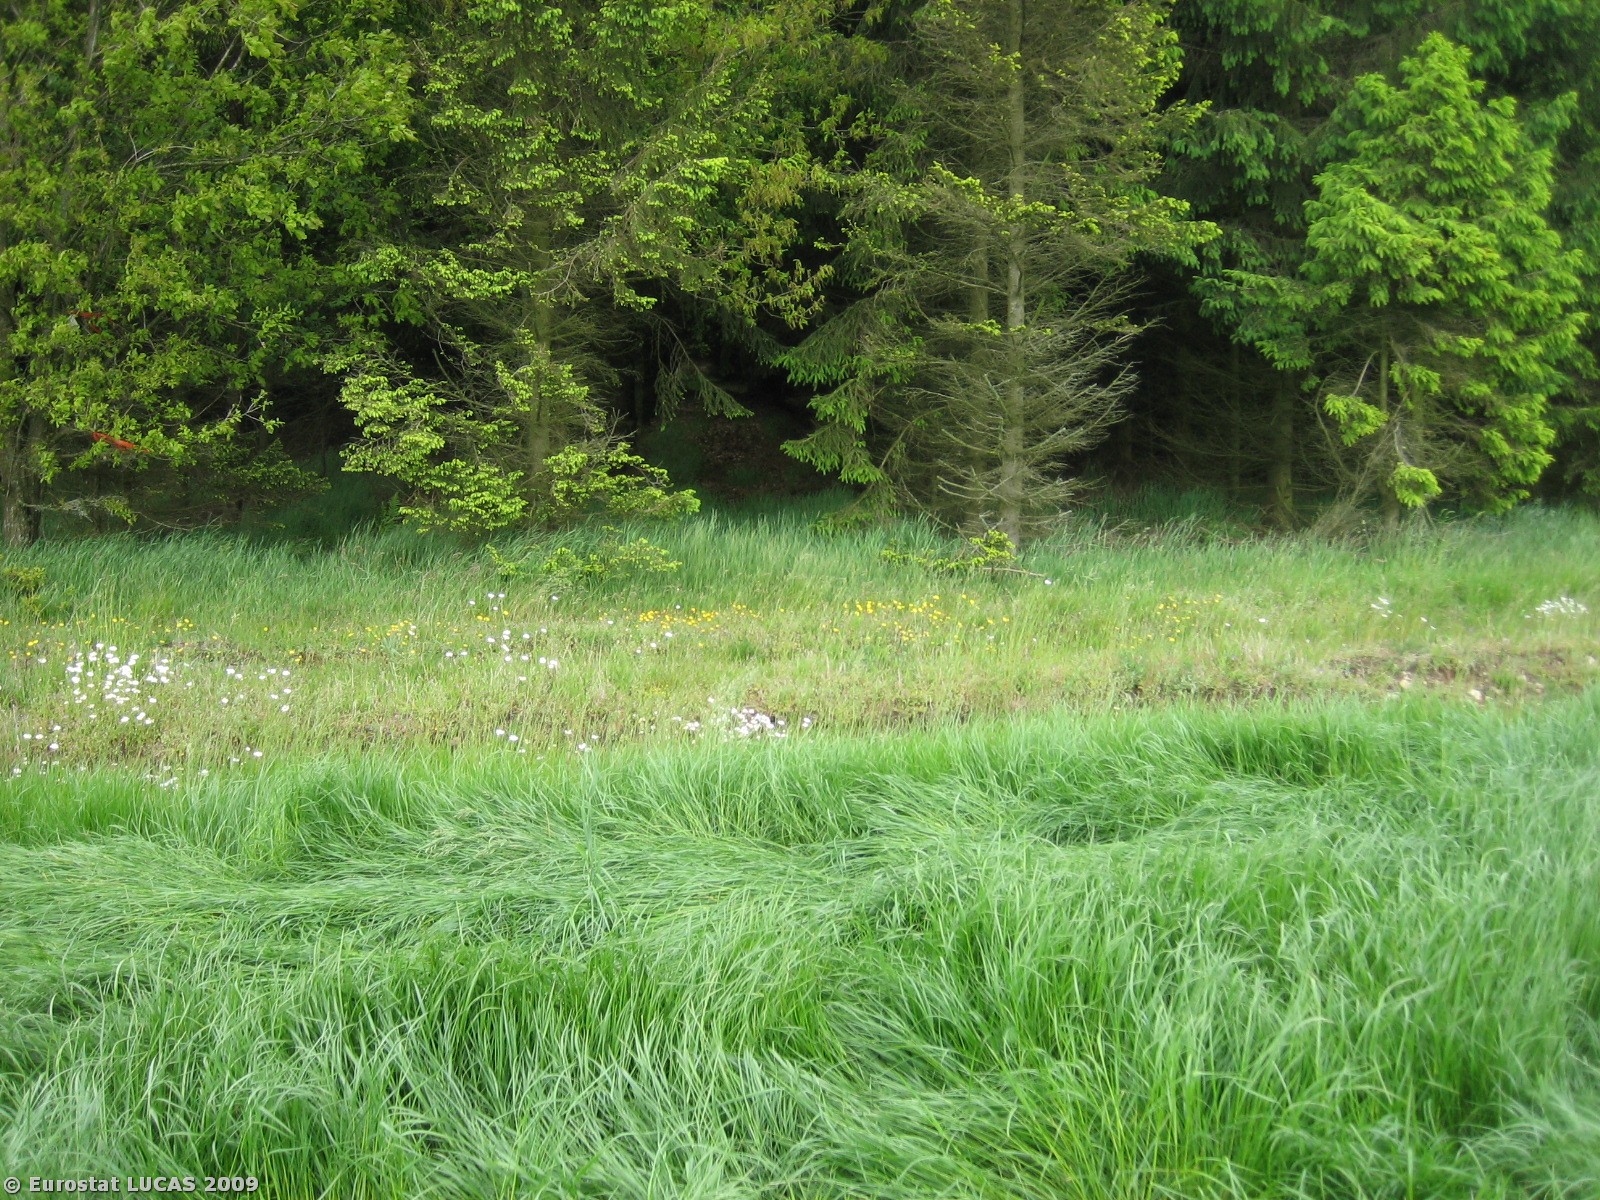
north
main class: Grassland
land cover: Grassland without tree/shrub cover
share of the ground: > 75 %
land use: Agriculture (excluding fallow land and kitchen gardens)
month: May
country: DK
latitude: 55.8264
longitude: 9.3143
